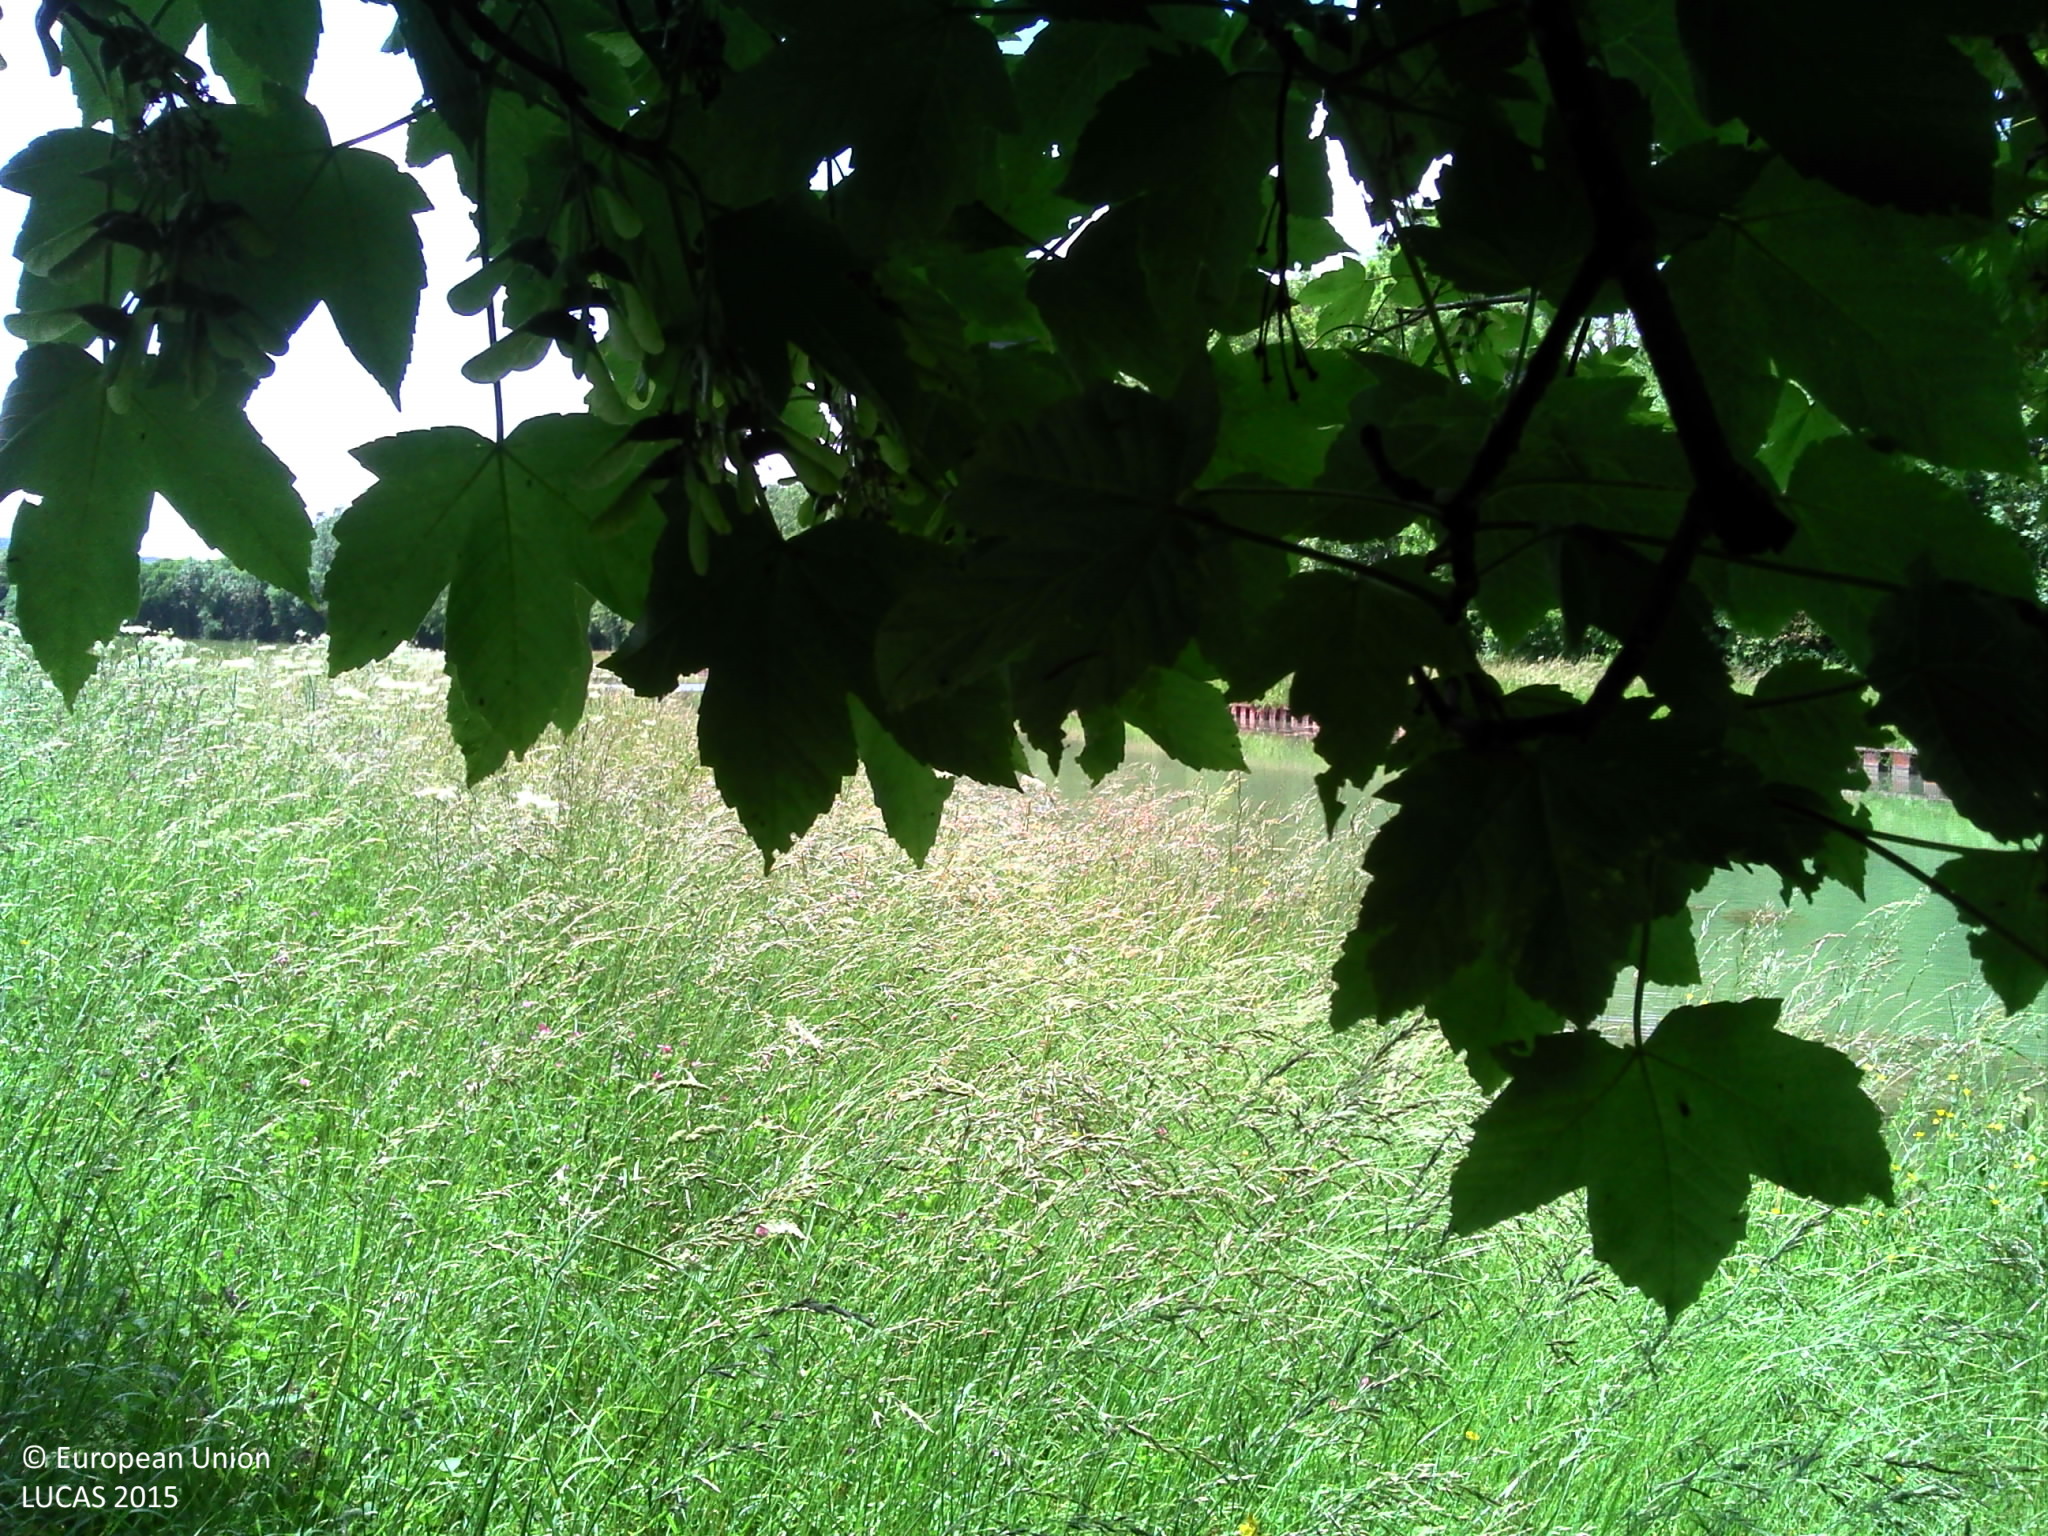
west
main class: Woodland
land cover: Broadleaved woodland
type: mesophytic deciduous forest
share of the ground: > 75 %
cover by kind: broadleaved forest trees 80 %, shrubs 20 %
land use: Semi-natural and natural areas not in use
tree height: > 5 m
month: May
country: FR
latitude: 47.3112
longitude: 4.8810
